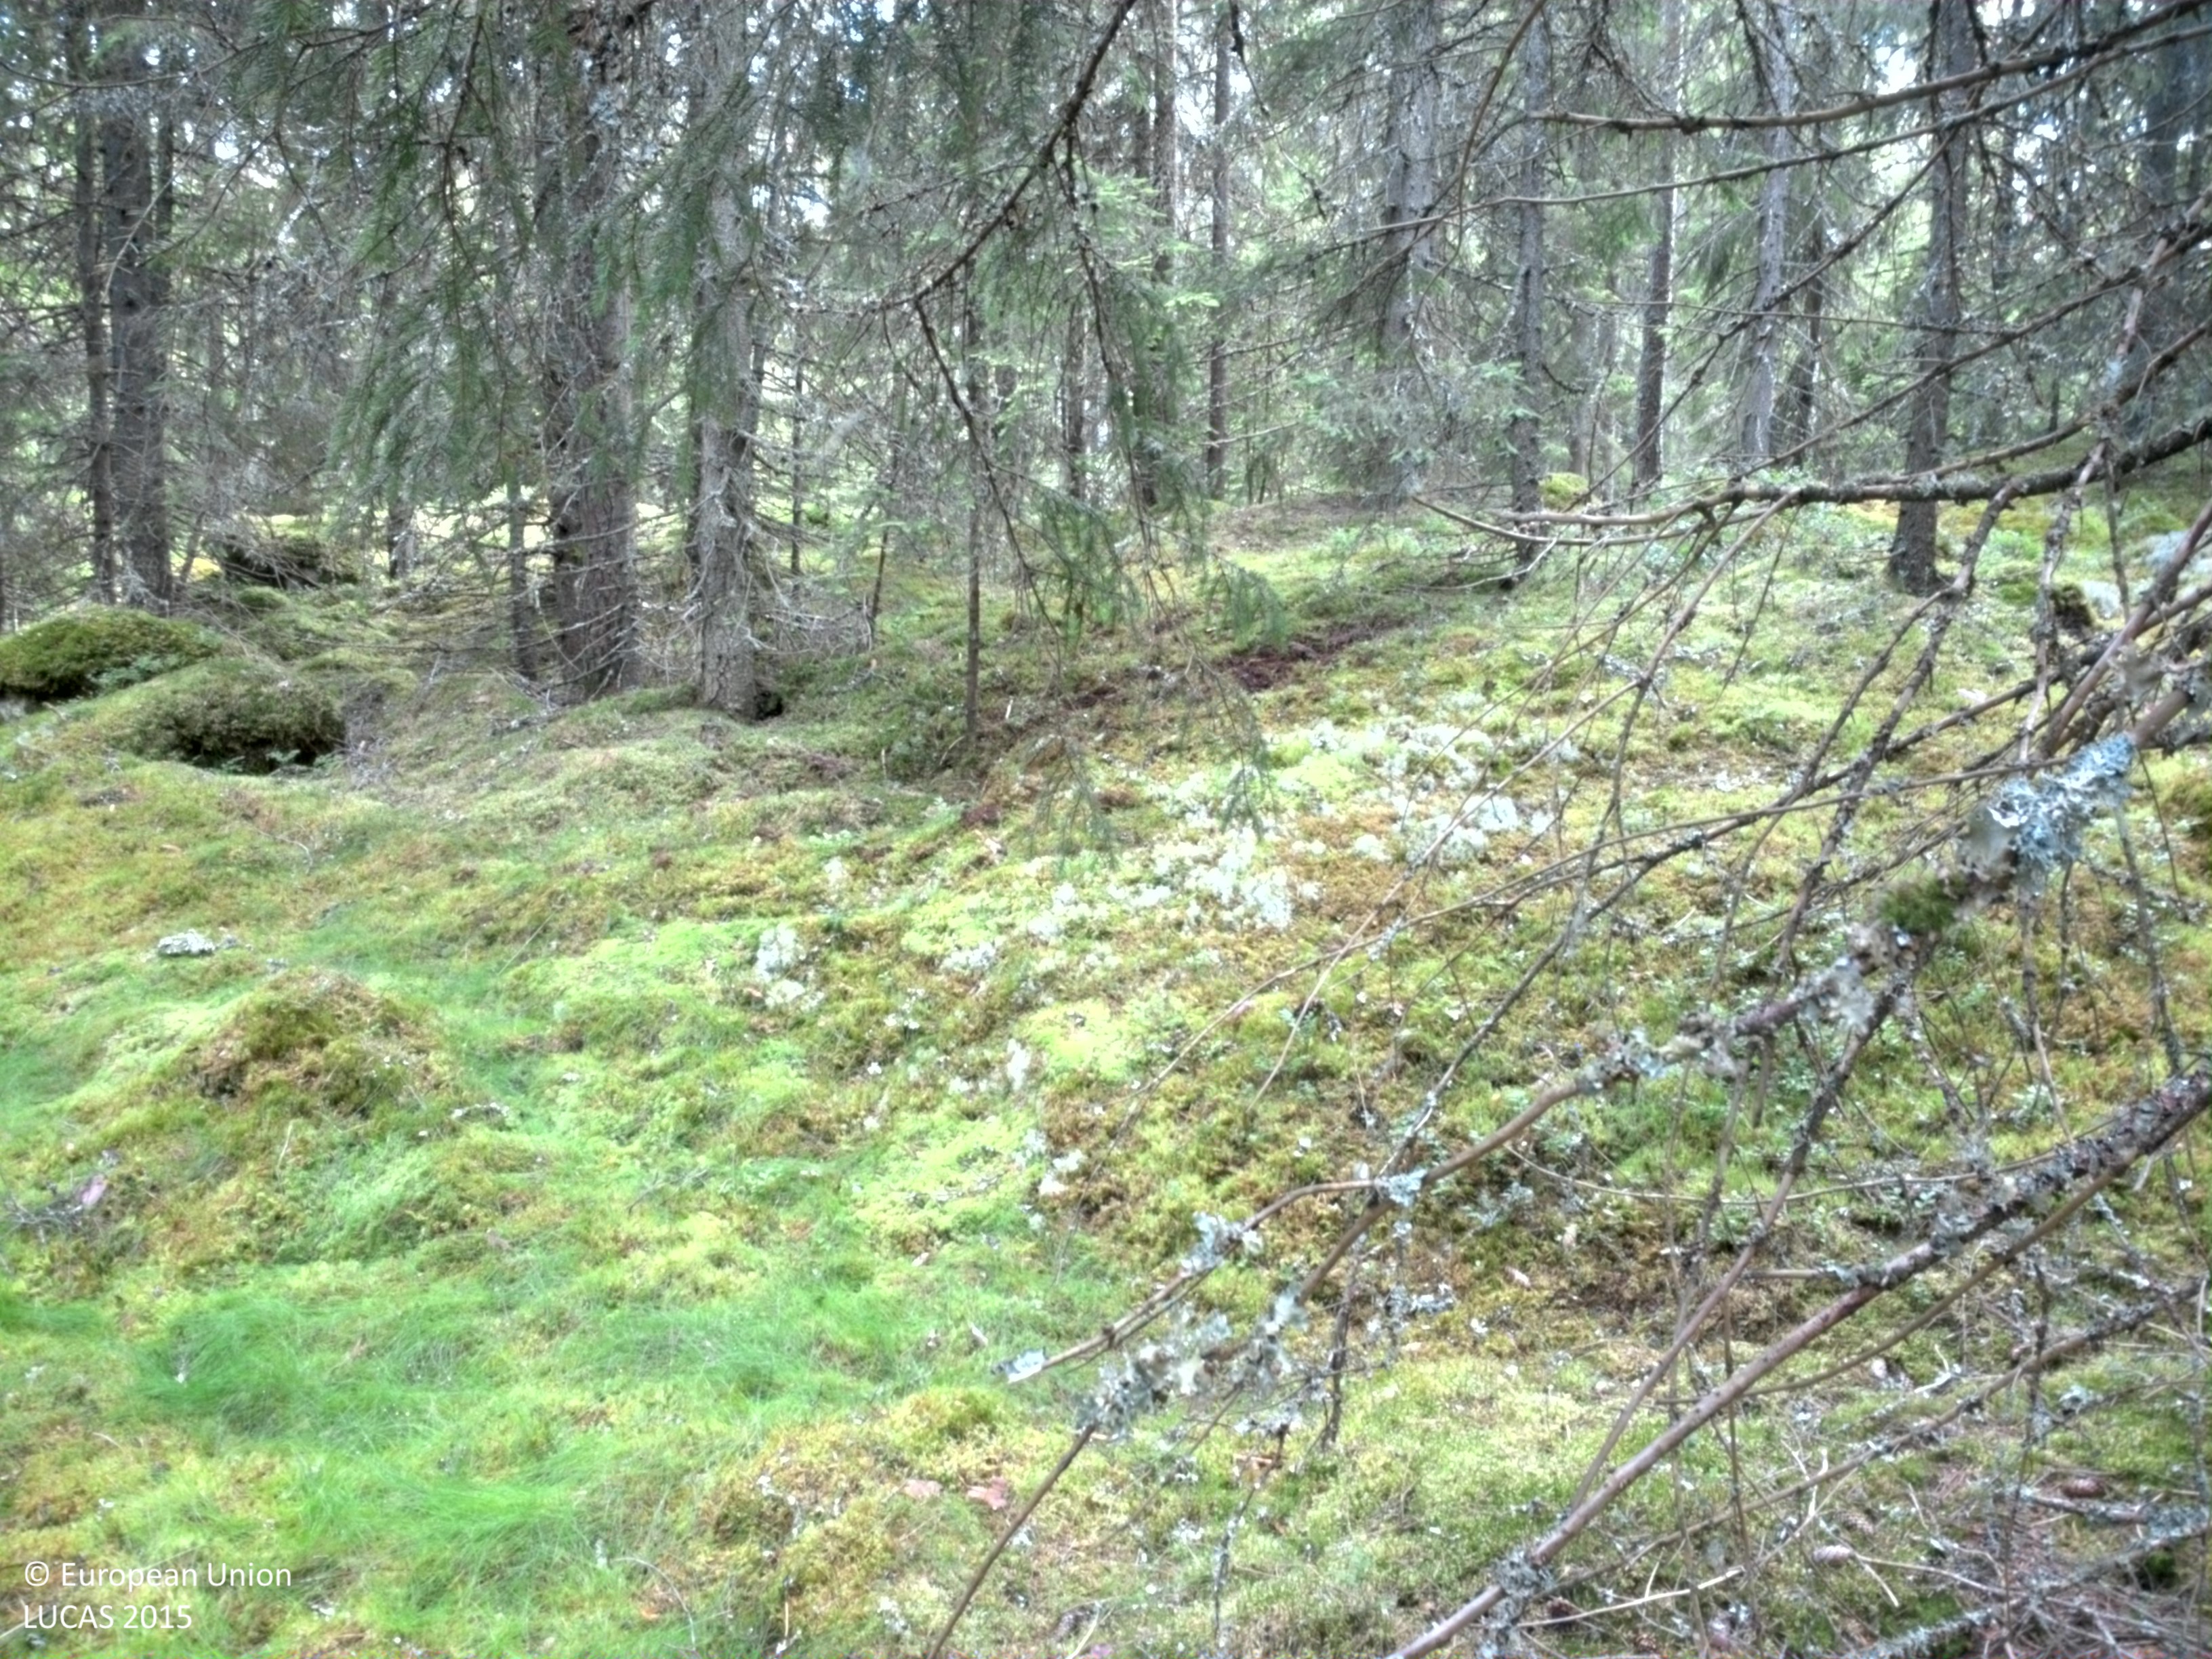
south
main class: Woodland
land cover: Spruce dominated coniferous woodland
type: boreal forest
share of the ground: > 75 %
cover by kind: coniferous forest trees 80 %, lichens and mosses 15 %, shrubs 5 %
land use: Forestry
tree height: > 5 m
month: July
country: SE
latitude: 57.6779
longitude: 14.4390
